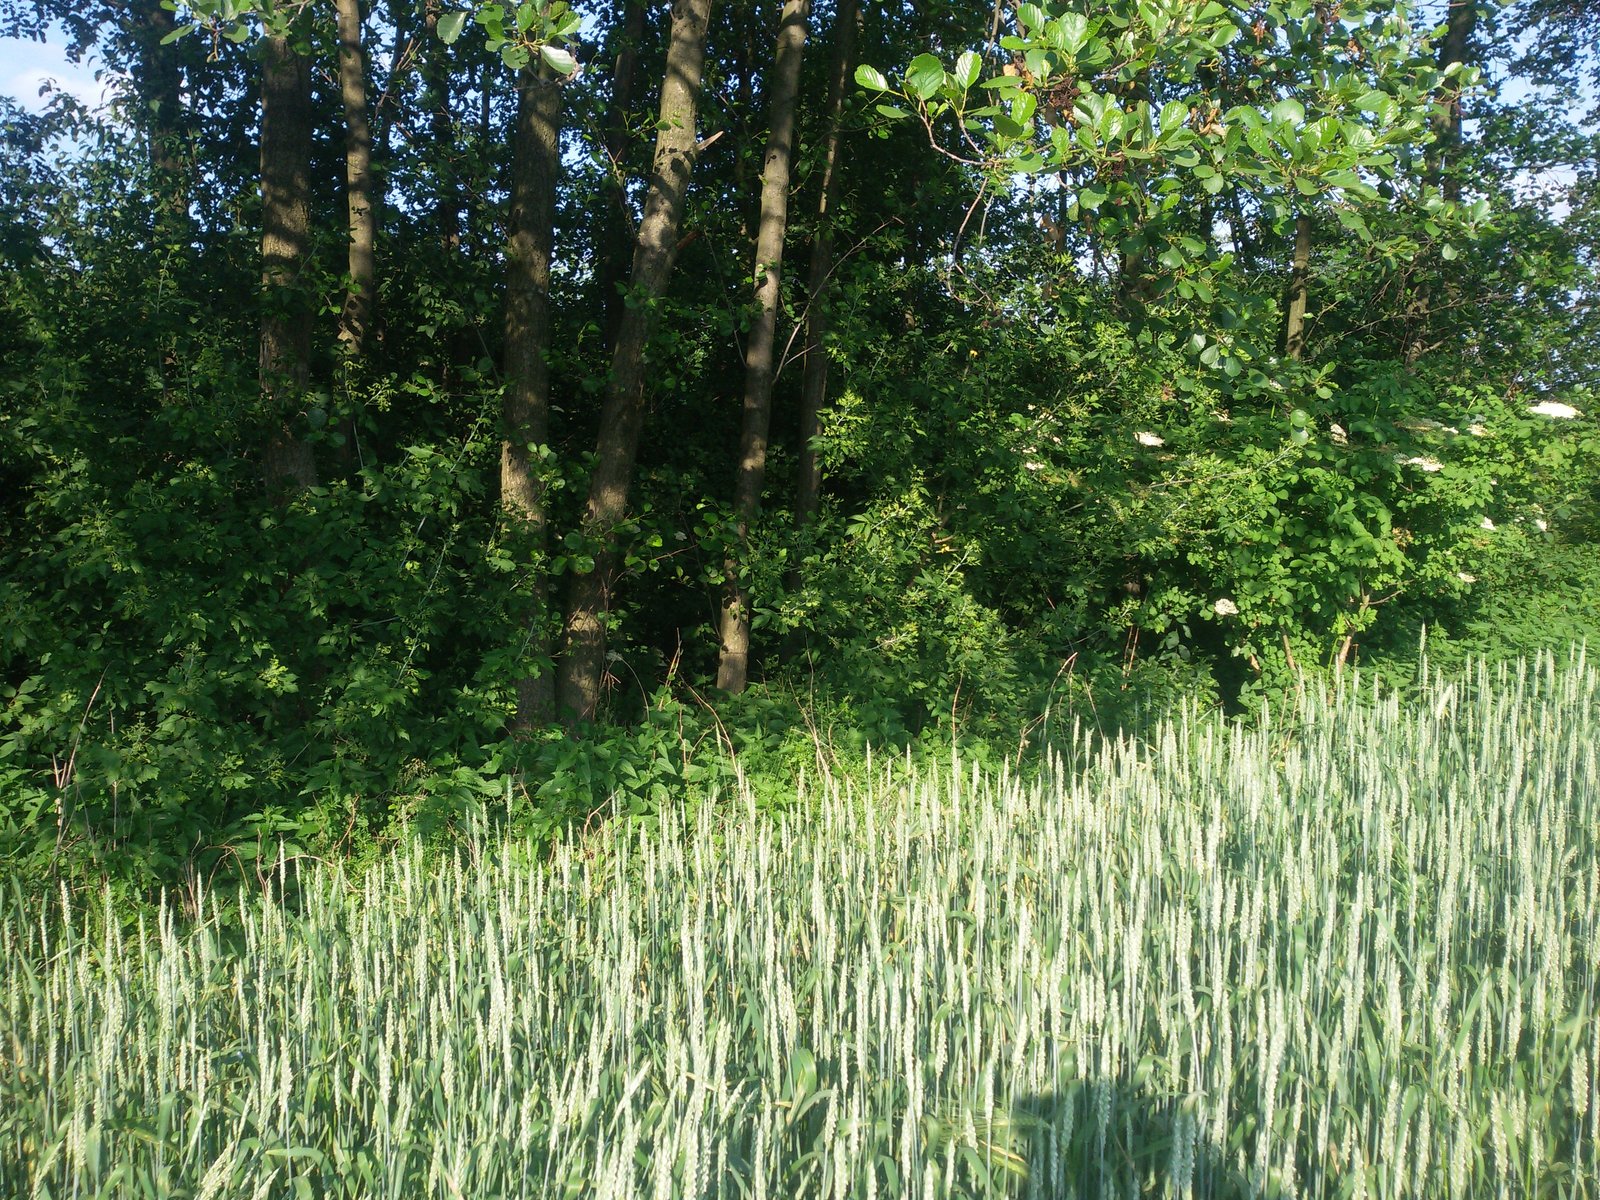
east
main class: Cropland
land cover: Common wheat
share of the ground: > 75 %
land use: Agriculture (excluding fallow land and kitchen gardens)
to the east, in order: Common wheat; Broadleaved woodland; Inland fresh running water; Shrubland with sparse tree cover; Grassland with sparse tree/shrub cover; Shrubland with sparse tree cover; Grassland without tree/shrub cover; Common wheat; Barley; Mixed cereals for fodder; Triticale; Mixed cereals for fodder; Grass margins; Potatoes; Mixed cereals for fodder
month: June
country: PL
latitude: 50.0973
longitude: 21.6129
